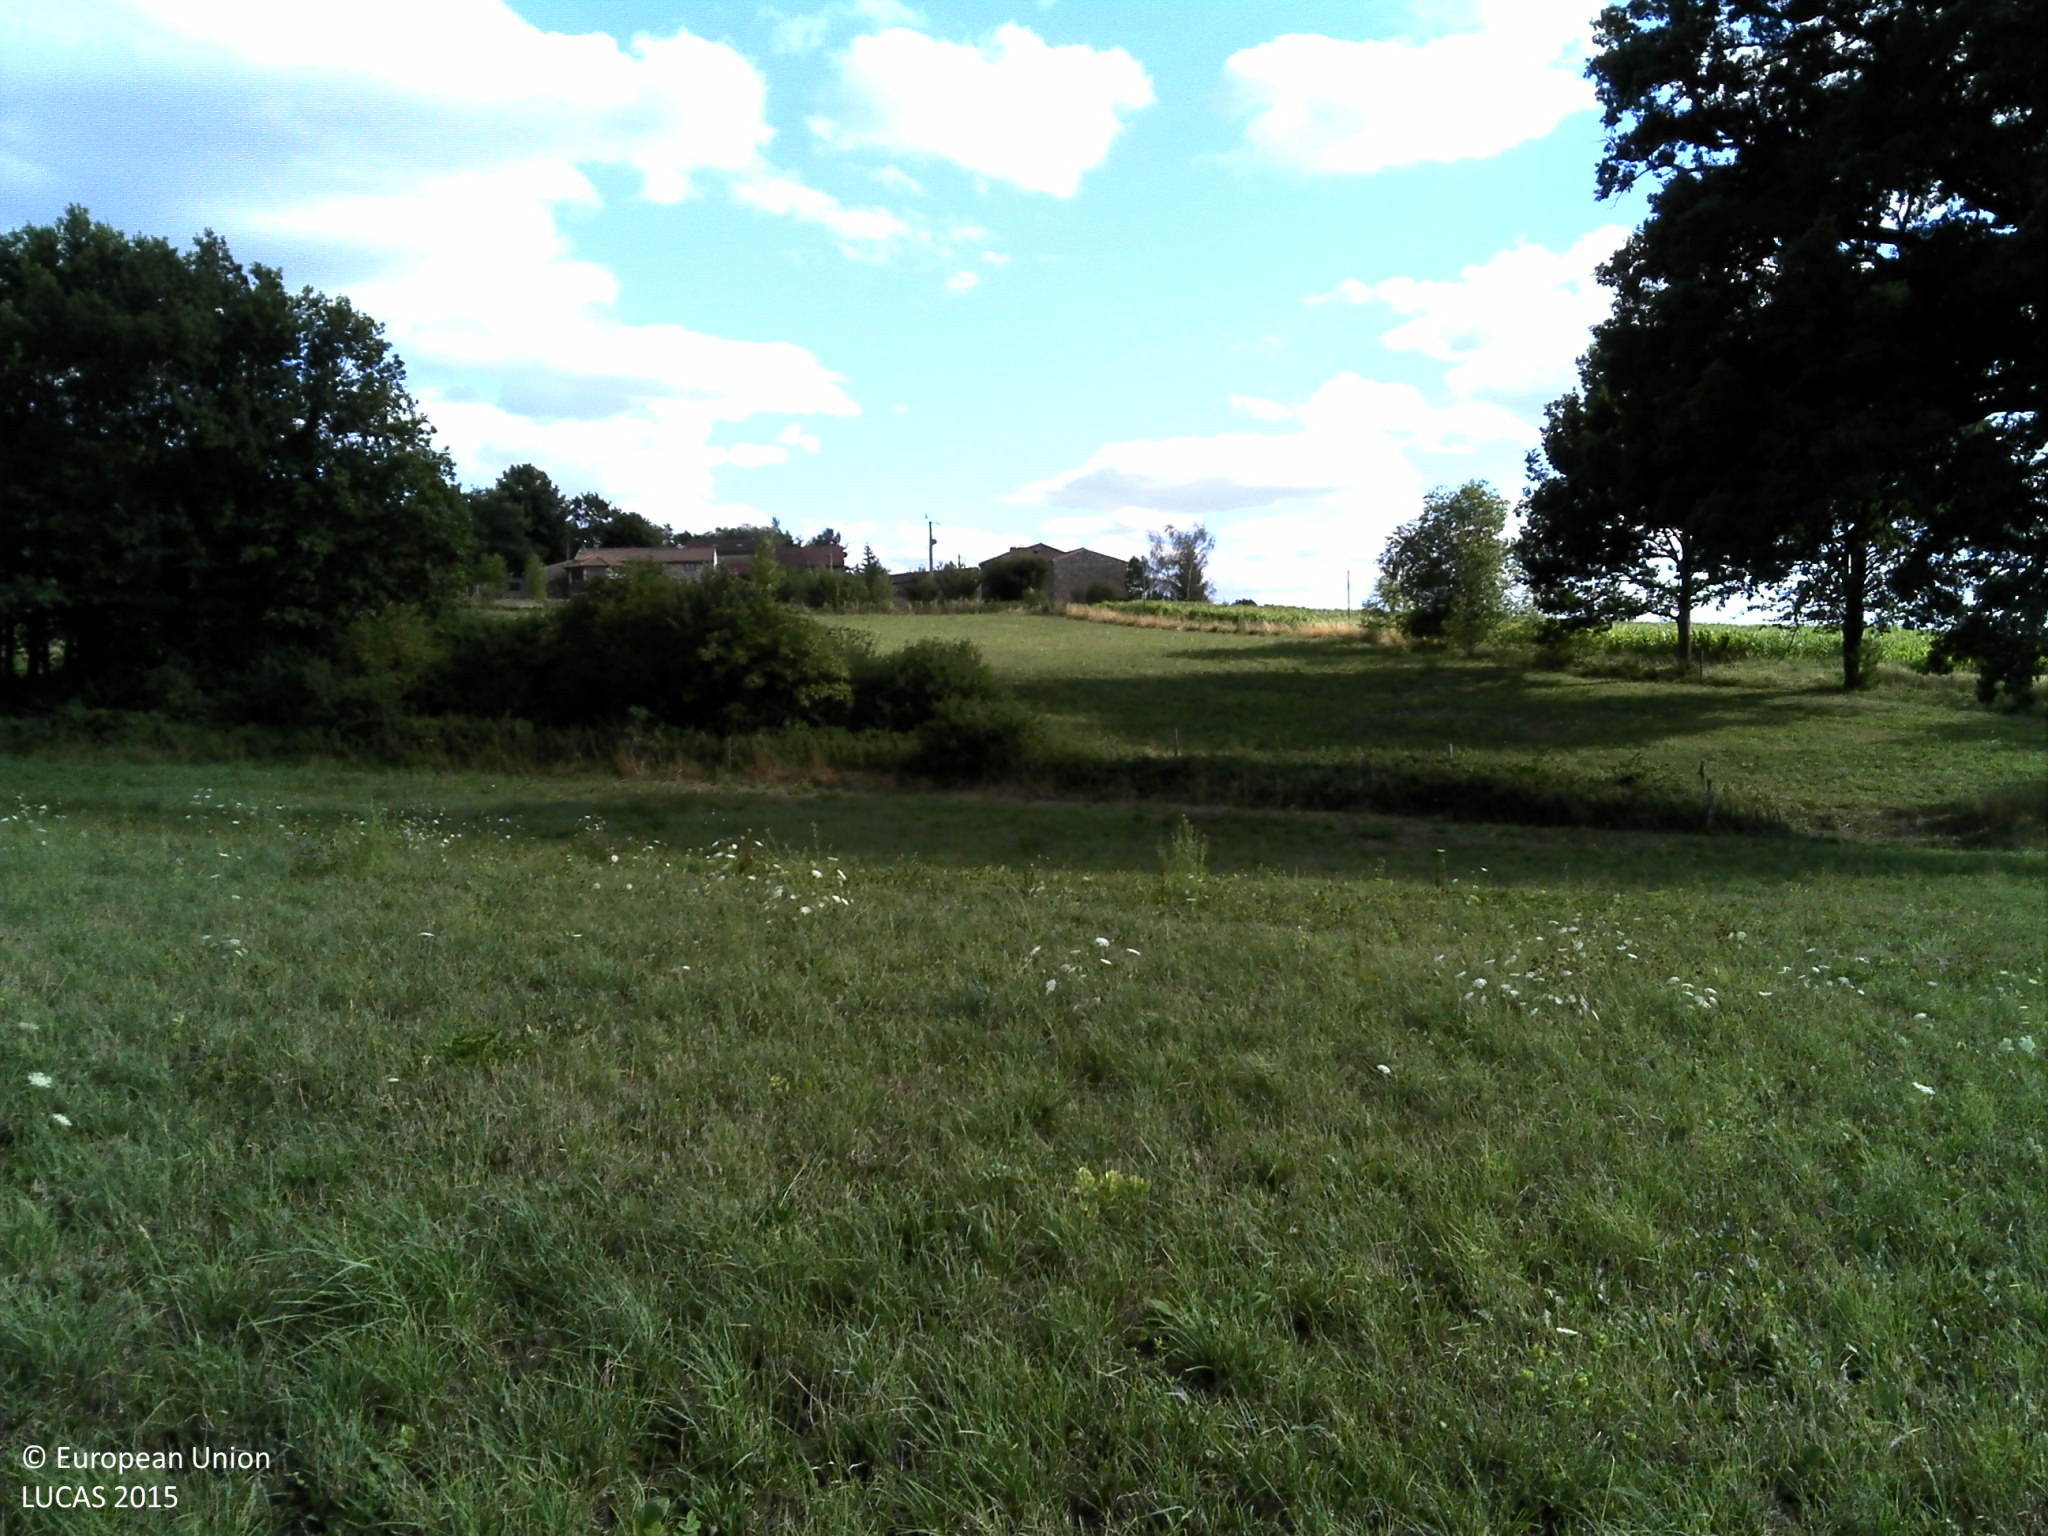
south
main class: Grassland
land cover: Grassland without tree/shrub cover
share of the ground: > 75 %
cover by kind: herbaceous plants 90 %, shrubs 5 %, lichens and mosses 5 %
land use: Agriculture (excluding fallow land and kitchen gardens)
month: July
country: FR
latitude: 45.5121
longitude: 3.3580
